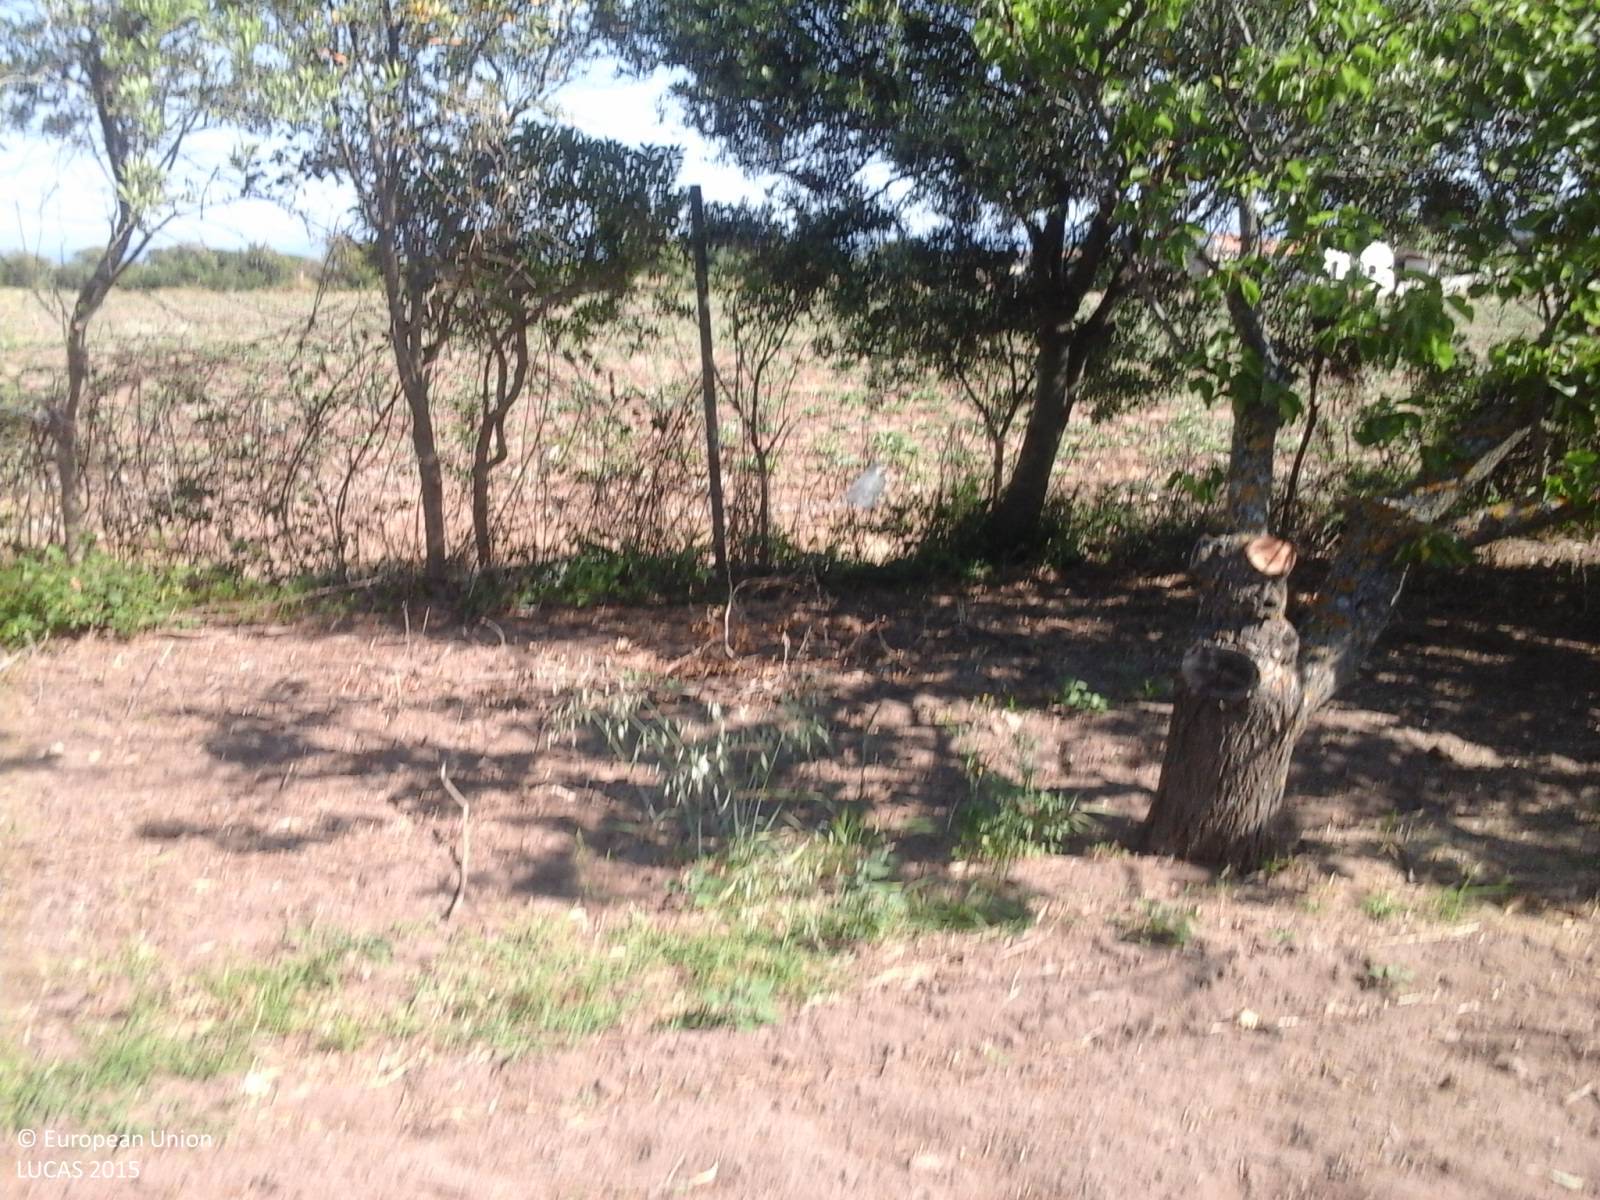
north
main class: Cropland
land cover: Other citrus fruit
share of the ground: < 10 %
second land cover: Other fresh vegetables
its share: < 10 %
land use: Agriculture (excluding fallow land and kitchen gardens)
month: June
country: IT
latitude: 40.9116
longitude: 8.8064
